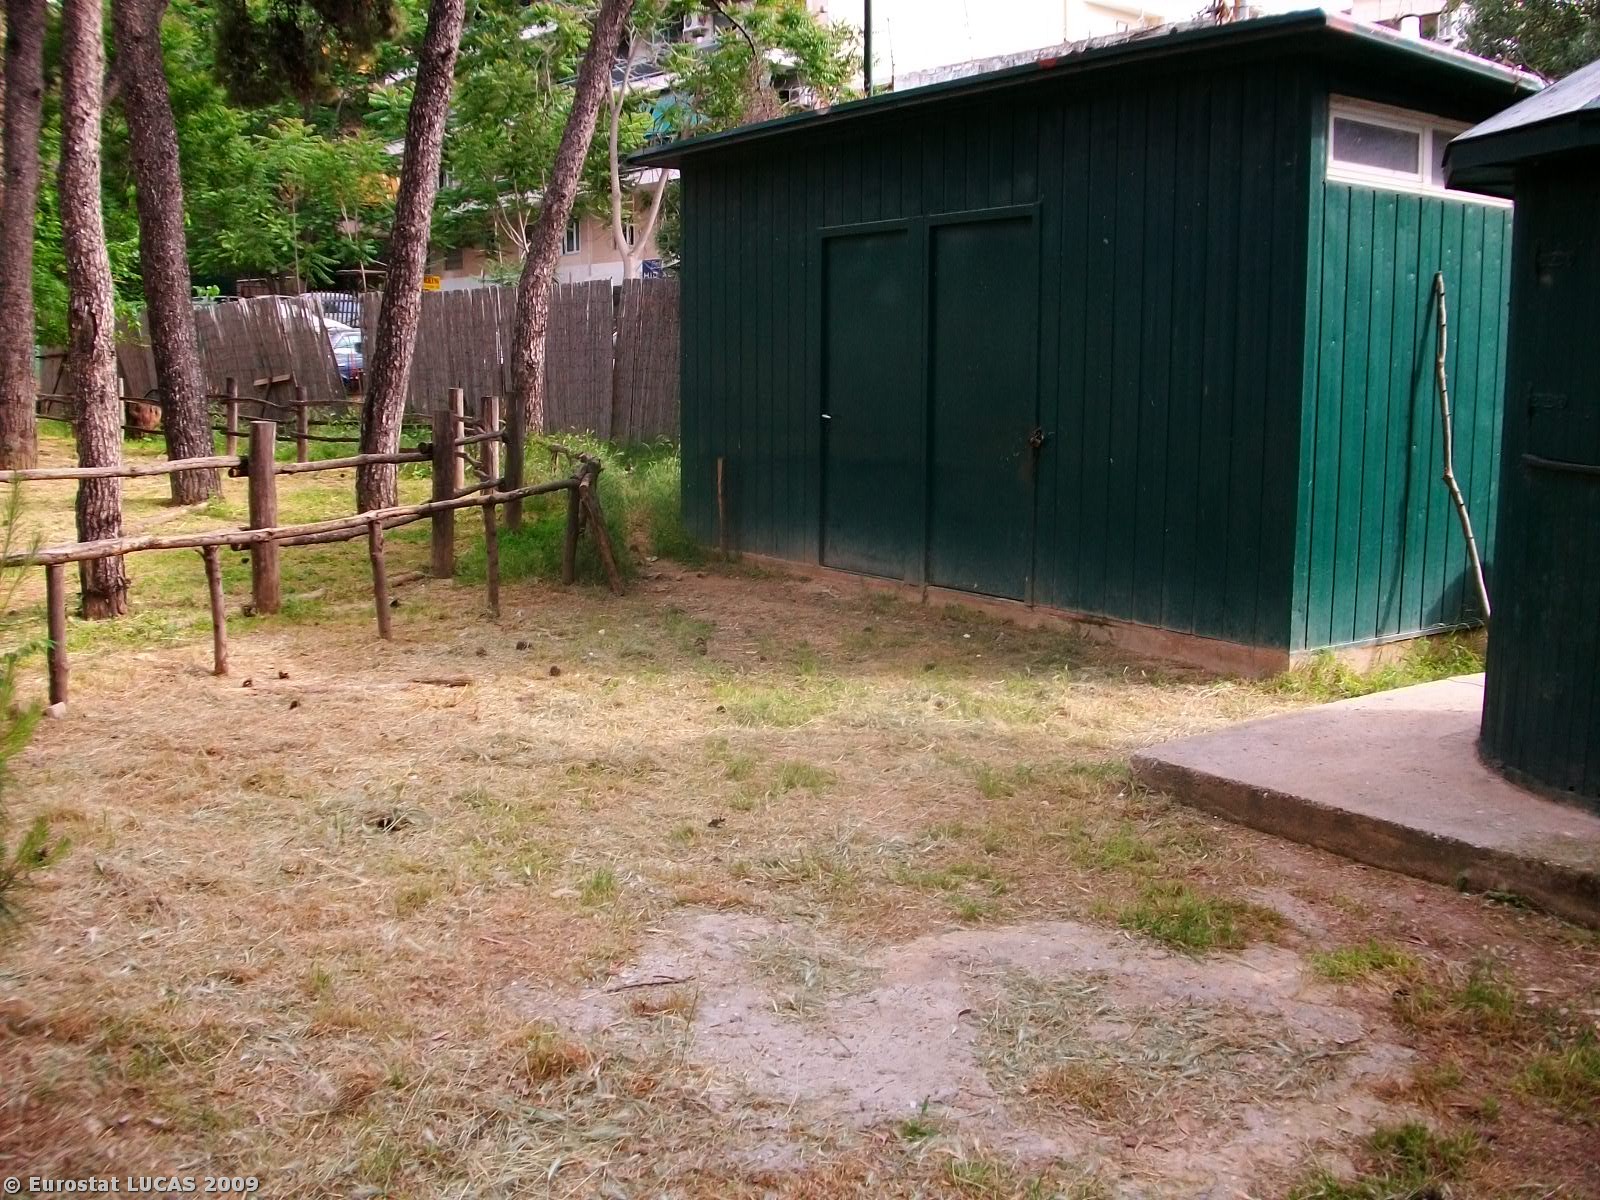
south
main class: Woodland
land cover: Coniferous woodland
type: coniferous forest of the mediterranean region
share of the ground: 50 - 75 %
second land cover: Spontaneously vegetated surfaces
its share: 50 - 75 %
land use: Amenities, museums, leisure
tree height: > 5 m
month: May
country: GR
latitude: 37.9892
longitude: 23.7698
